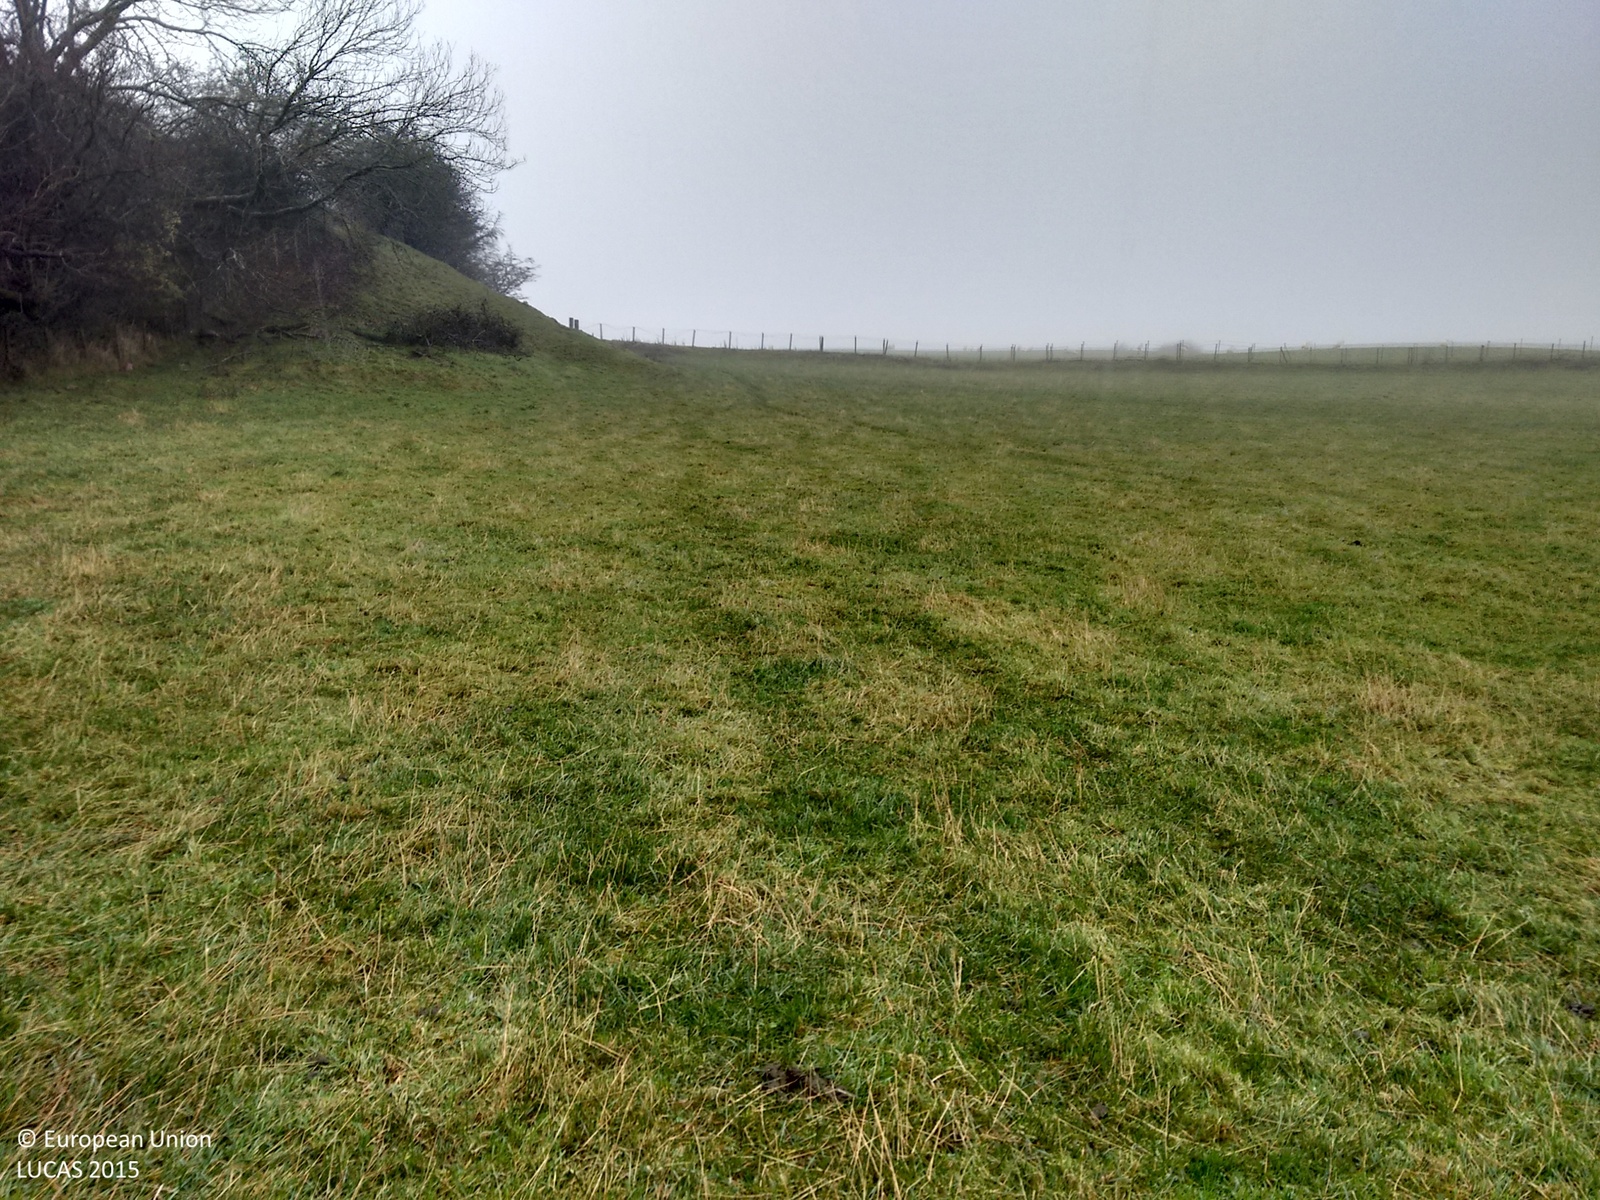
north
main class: Grassland
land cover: Grassland without tree/shrub cover
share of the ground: > 75 %
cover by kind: herbaceous plants 100 %
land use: Agriculture (excluding fallow land and kitchen gardens)
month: November
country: GB
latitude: 54.5442
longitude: -3.4521
